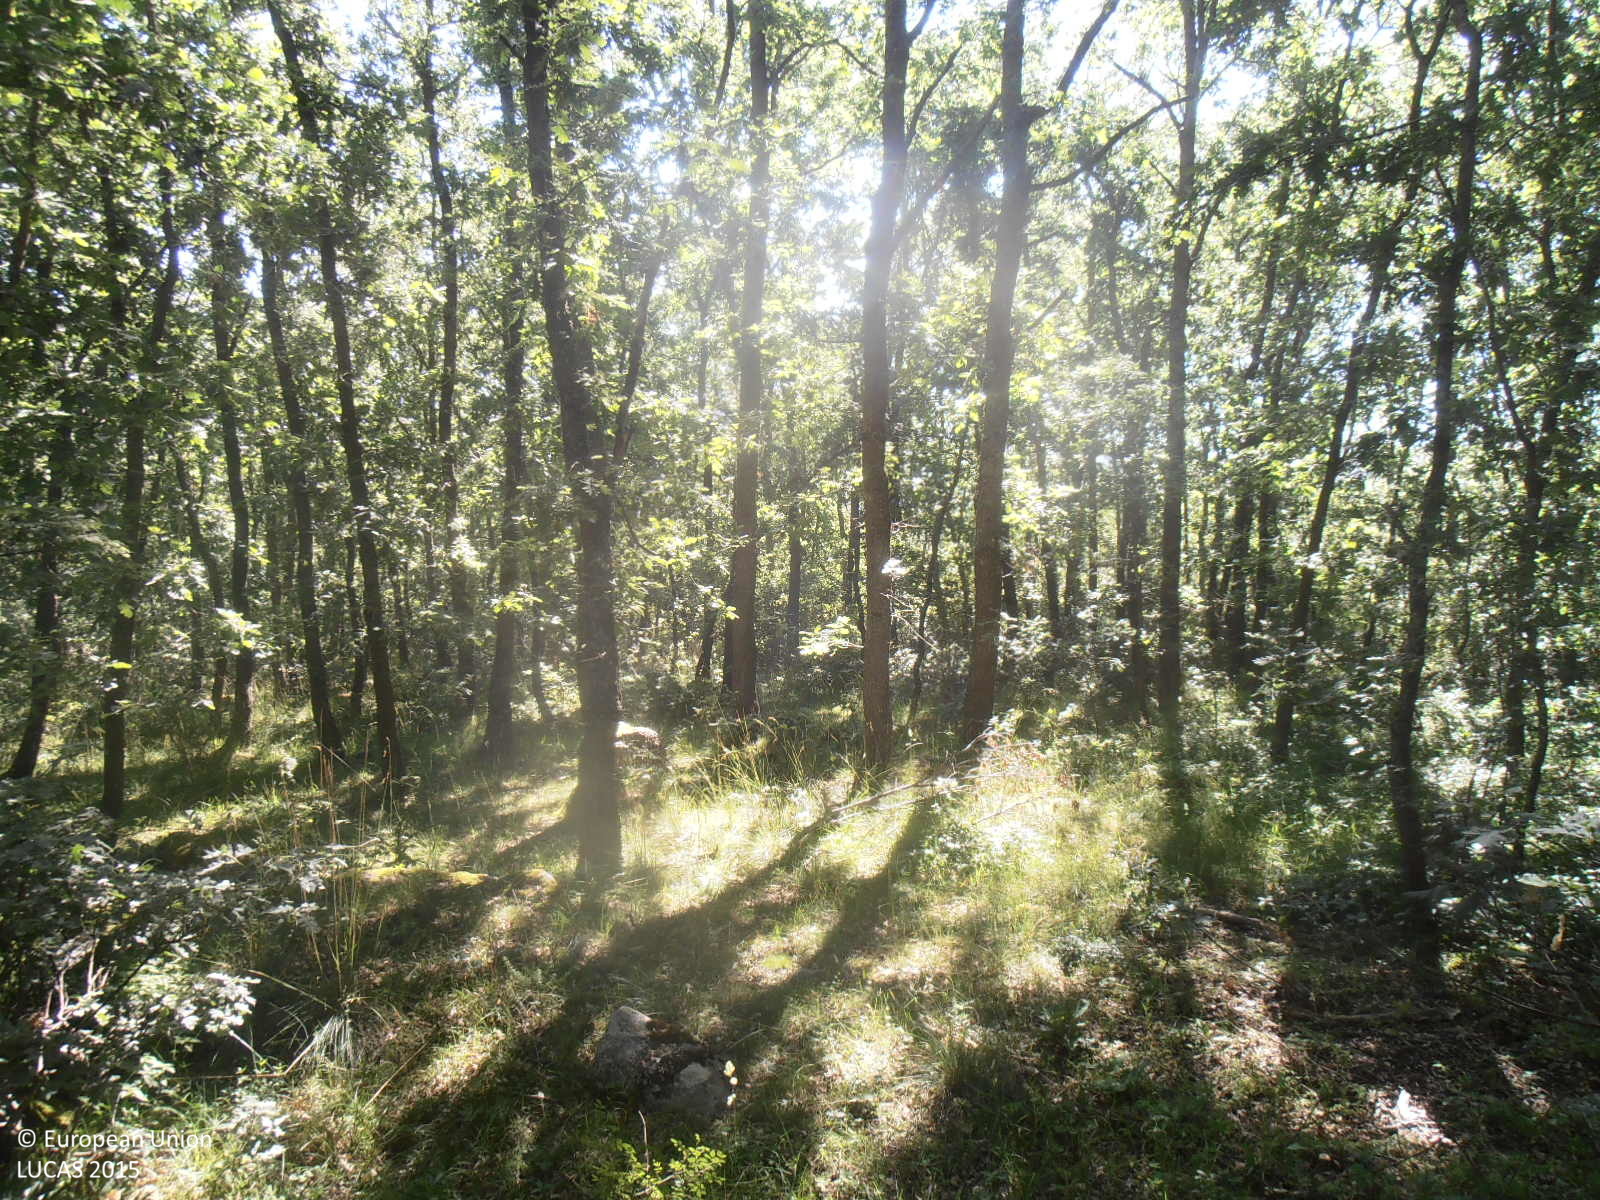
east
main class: Woodland
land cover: Broadleaved woodland
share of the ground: > 75 %
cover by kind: broadleaved forest trees 90 %, herbaceous plants 10 %
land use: Semi-natural and natural areas not in use
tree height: < 5 m
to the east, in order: Broadleaved woodland; Shrubland without tree cover; Tracks; Shrubland without tree cover; Broadleaved woodland; Shrubland without tree cover; Broadleaved woodland
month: June
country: ES
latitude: 41.7584
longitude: -1.9758
